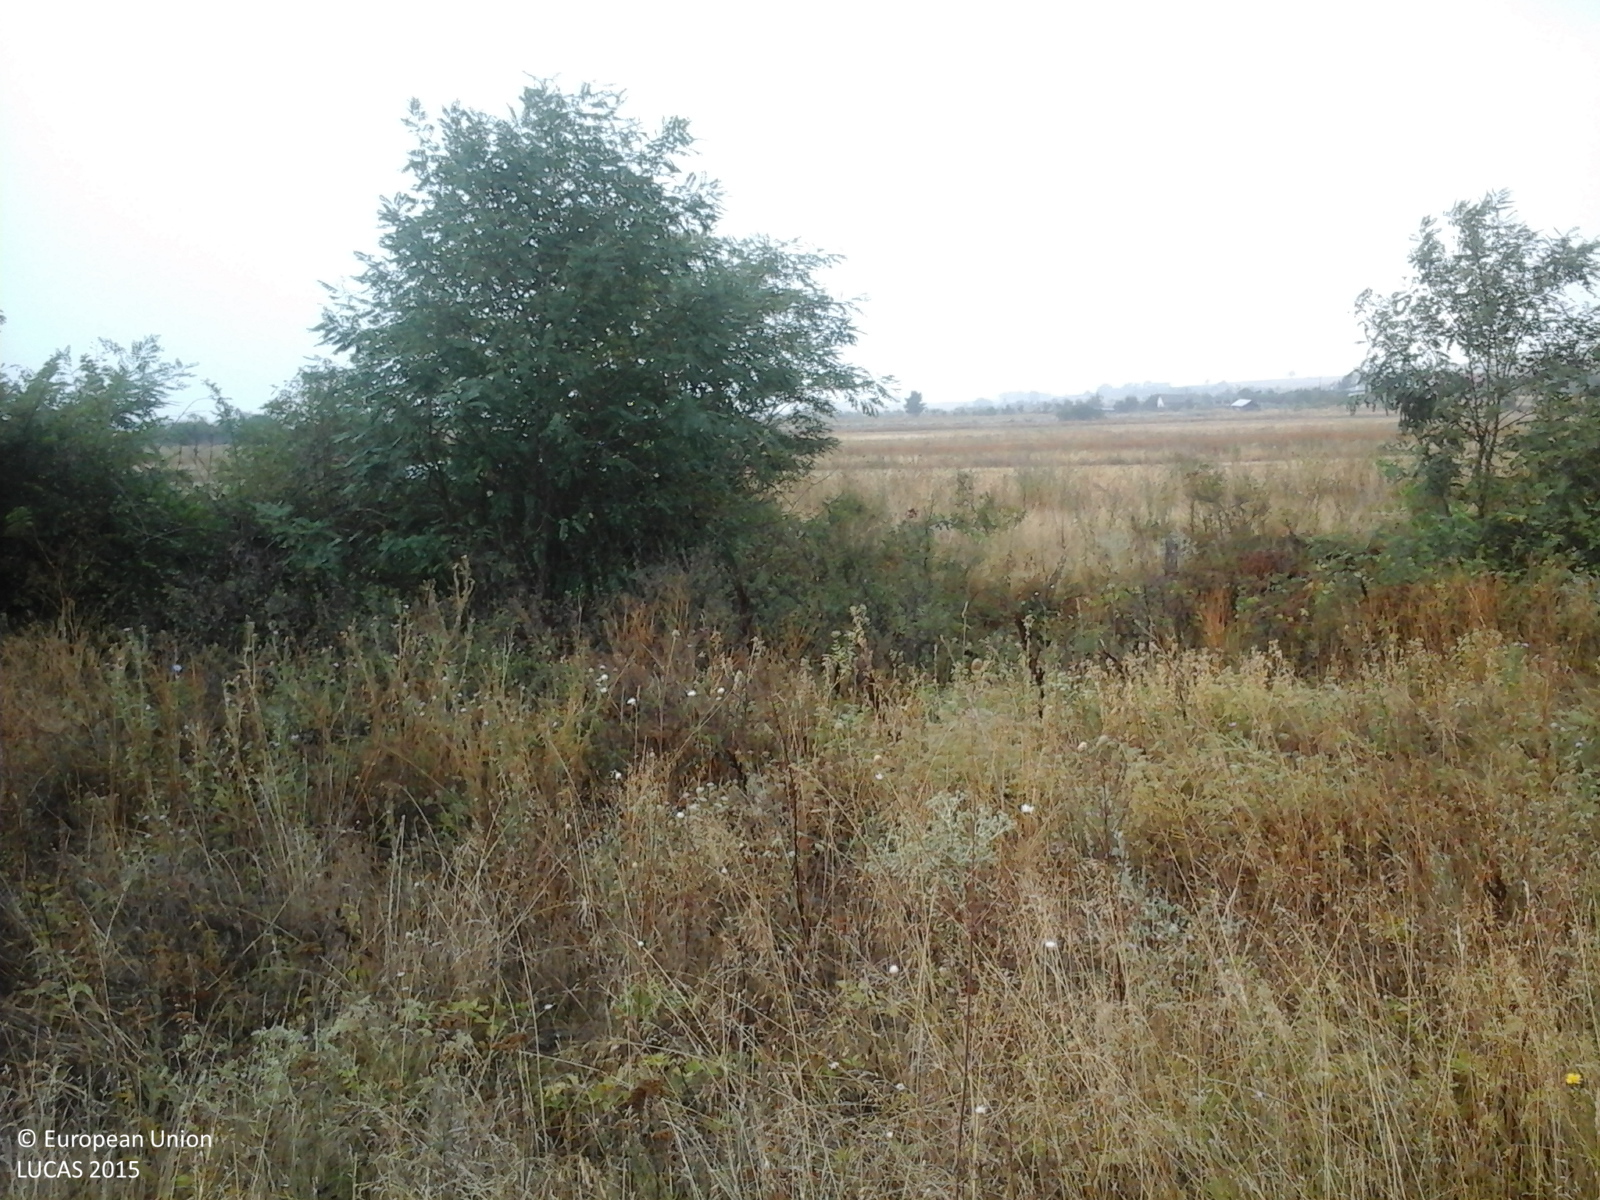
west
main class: Grassland
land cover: Spontaneously vegetated surfaces
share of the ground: > 75 %
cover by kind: herbaceous plants 100 %
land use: Fallow land
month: August
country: RO
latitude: 44.7315
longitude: 21.6332
